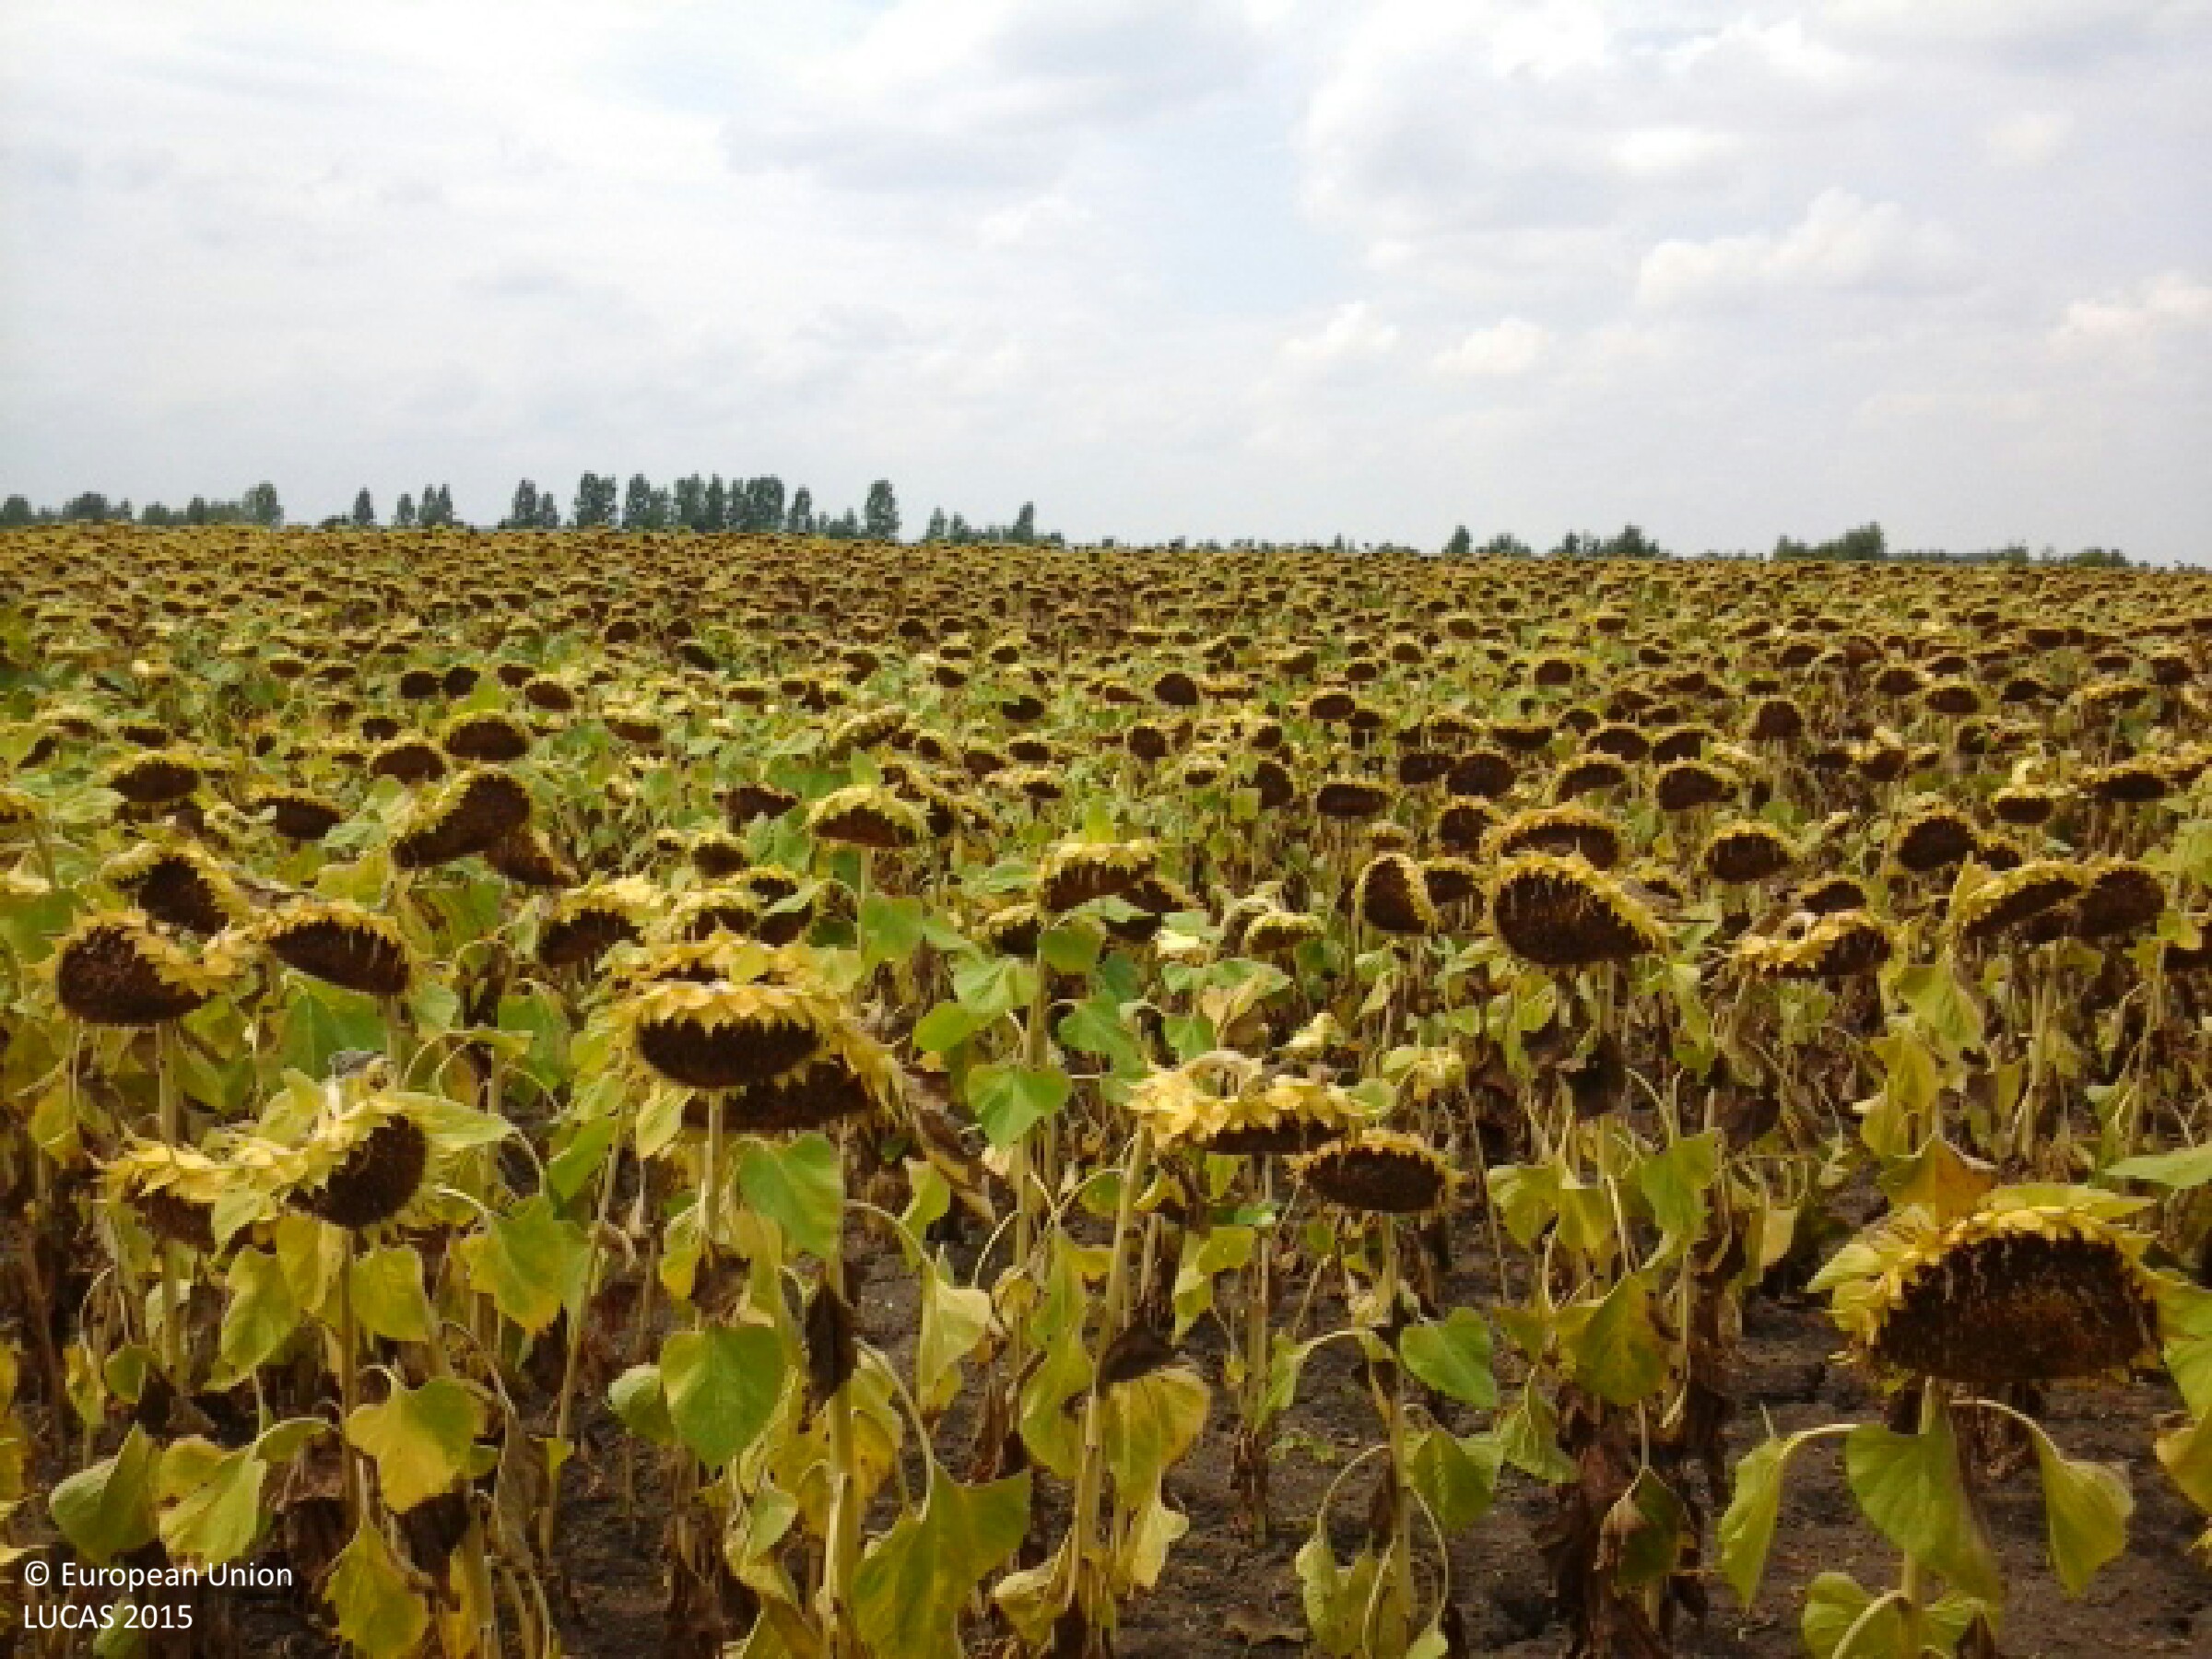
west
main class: Cropland
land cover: Sunflower
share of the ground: > 75 %
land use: Agriculture (excluding fallow land and kitchen gardens)
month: August
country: HU
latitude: 47.1477
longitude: 21.6613
